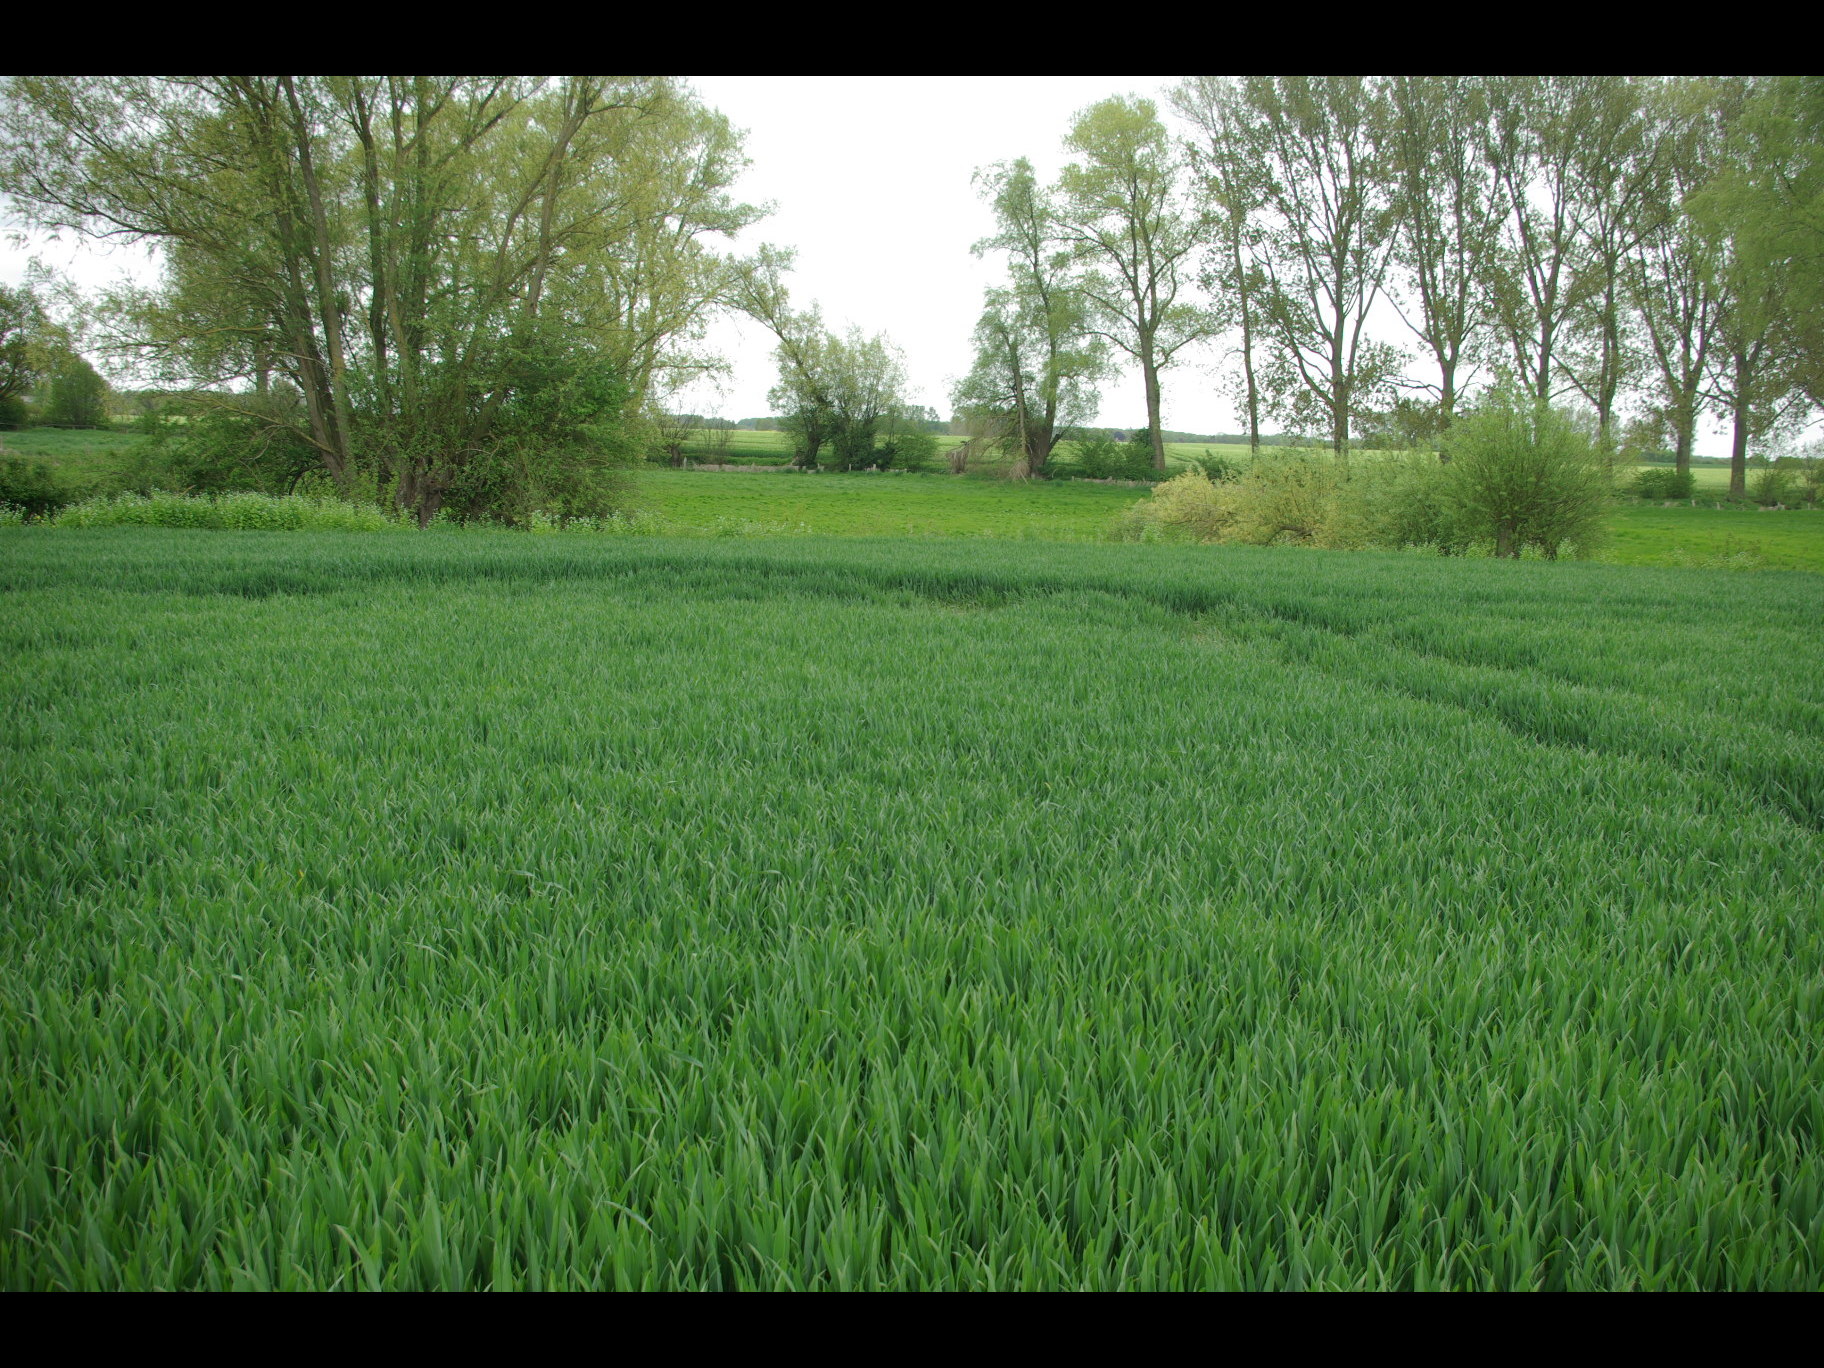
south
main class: Cropland
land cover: Common wheat
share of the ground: > 75 %
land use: Agriculture (excluding fallow land and kitchen gardens)
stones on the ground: < 10 %
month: May
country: DE
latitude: 54.2066
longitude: 10.9960
